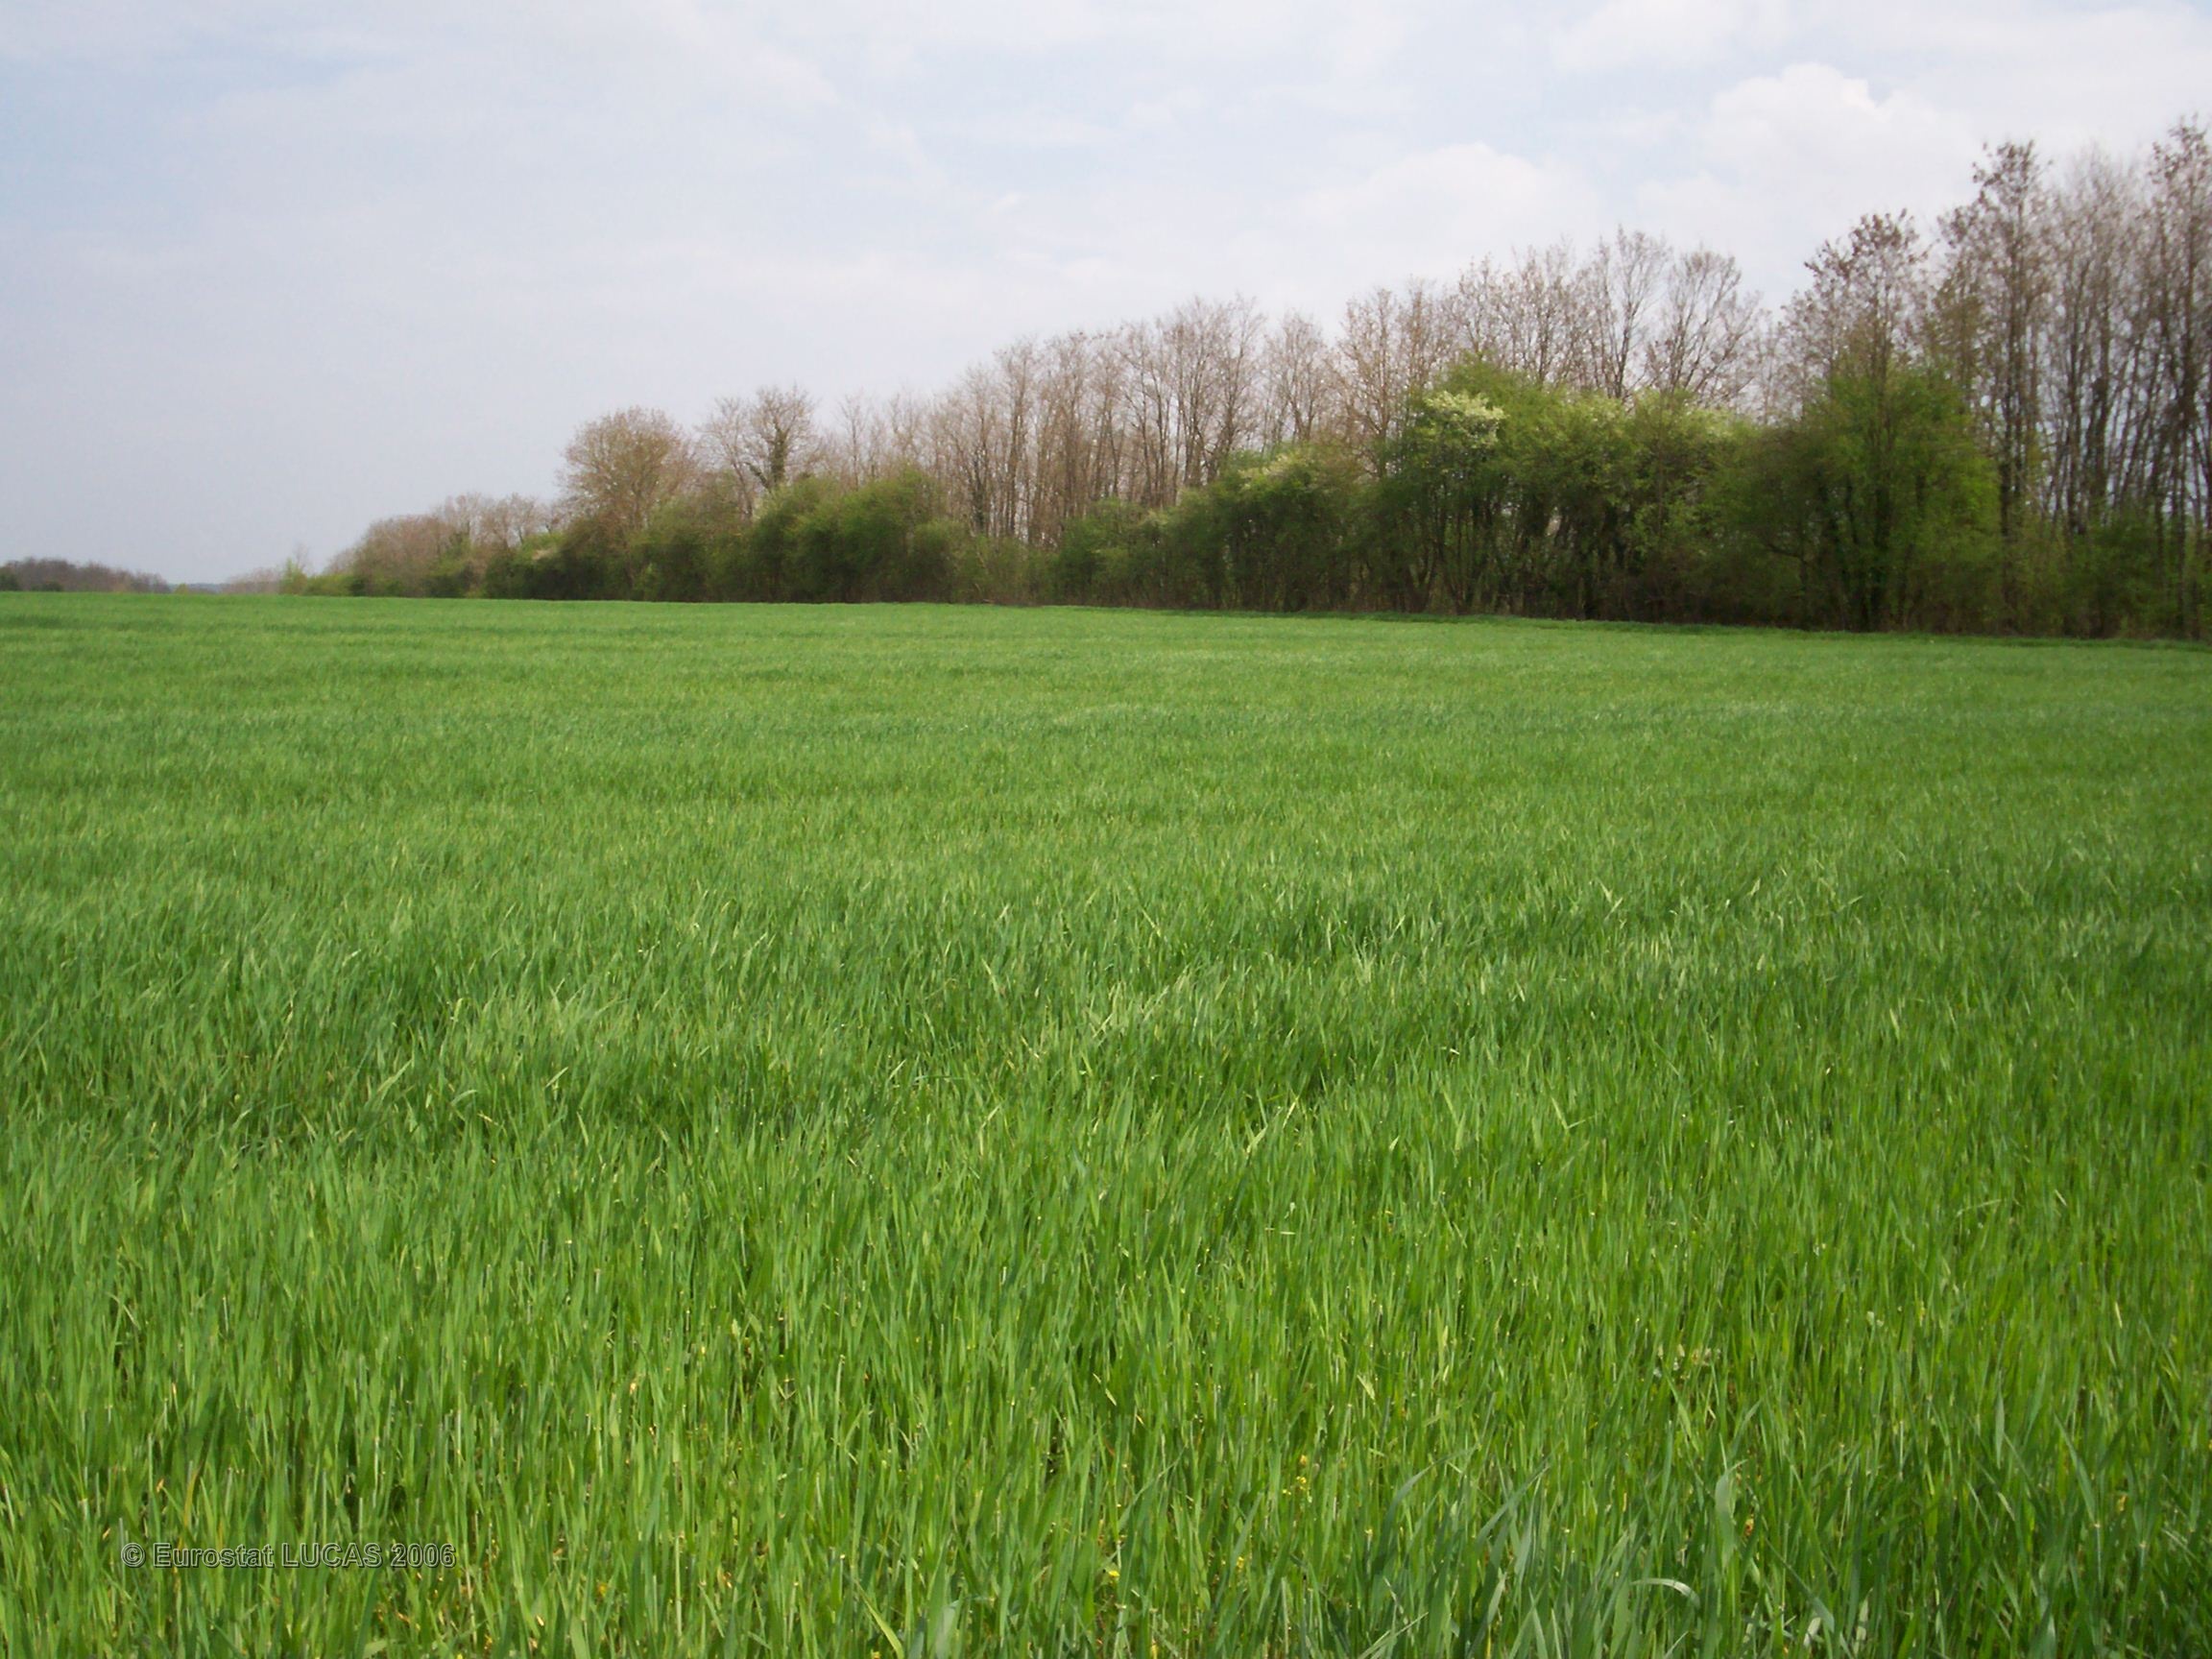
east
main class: Cropland
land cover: Maize
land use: Agriculture (excluding fallow land and kitchen gardens)
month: June
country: FR
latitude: 47.5744
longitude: 5.9997
